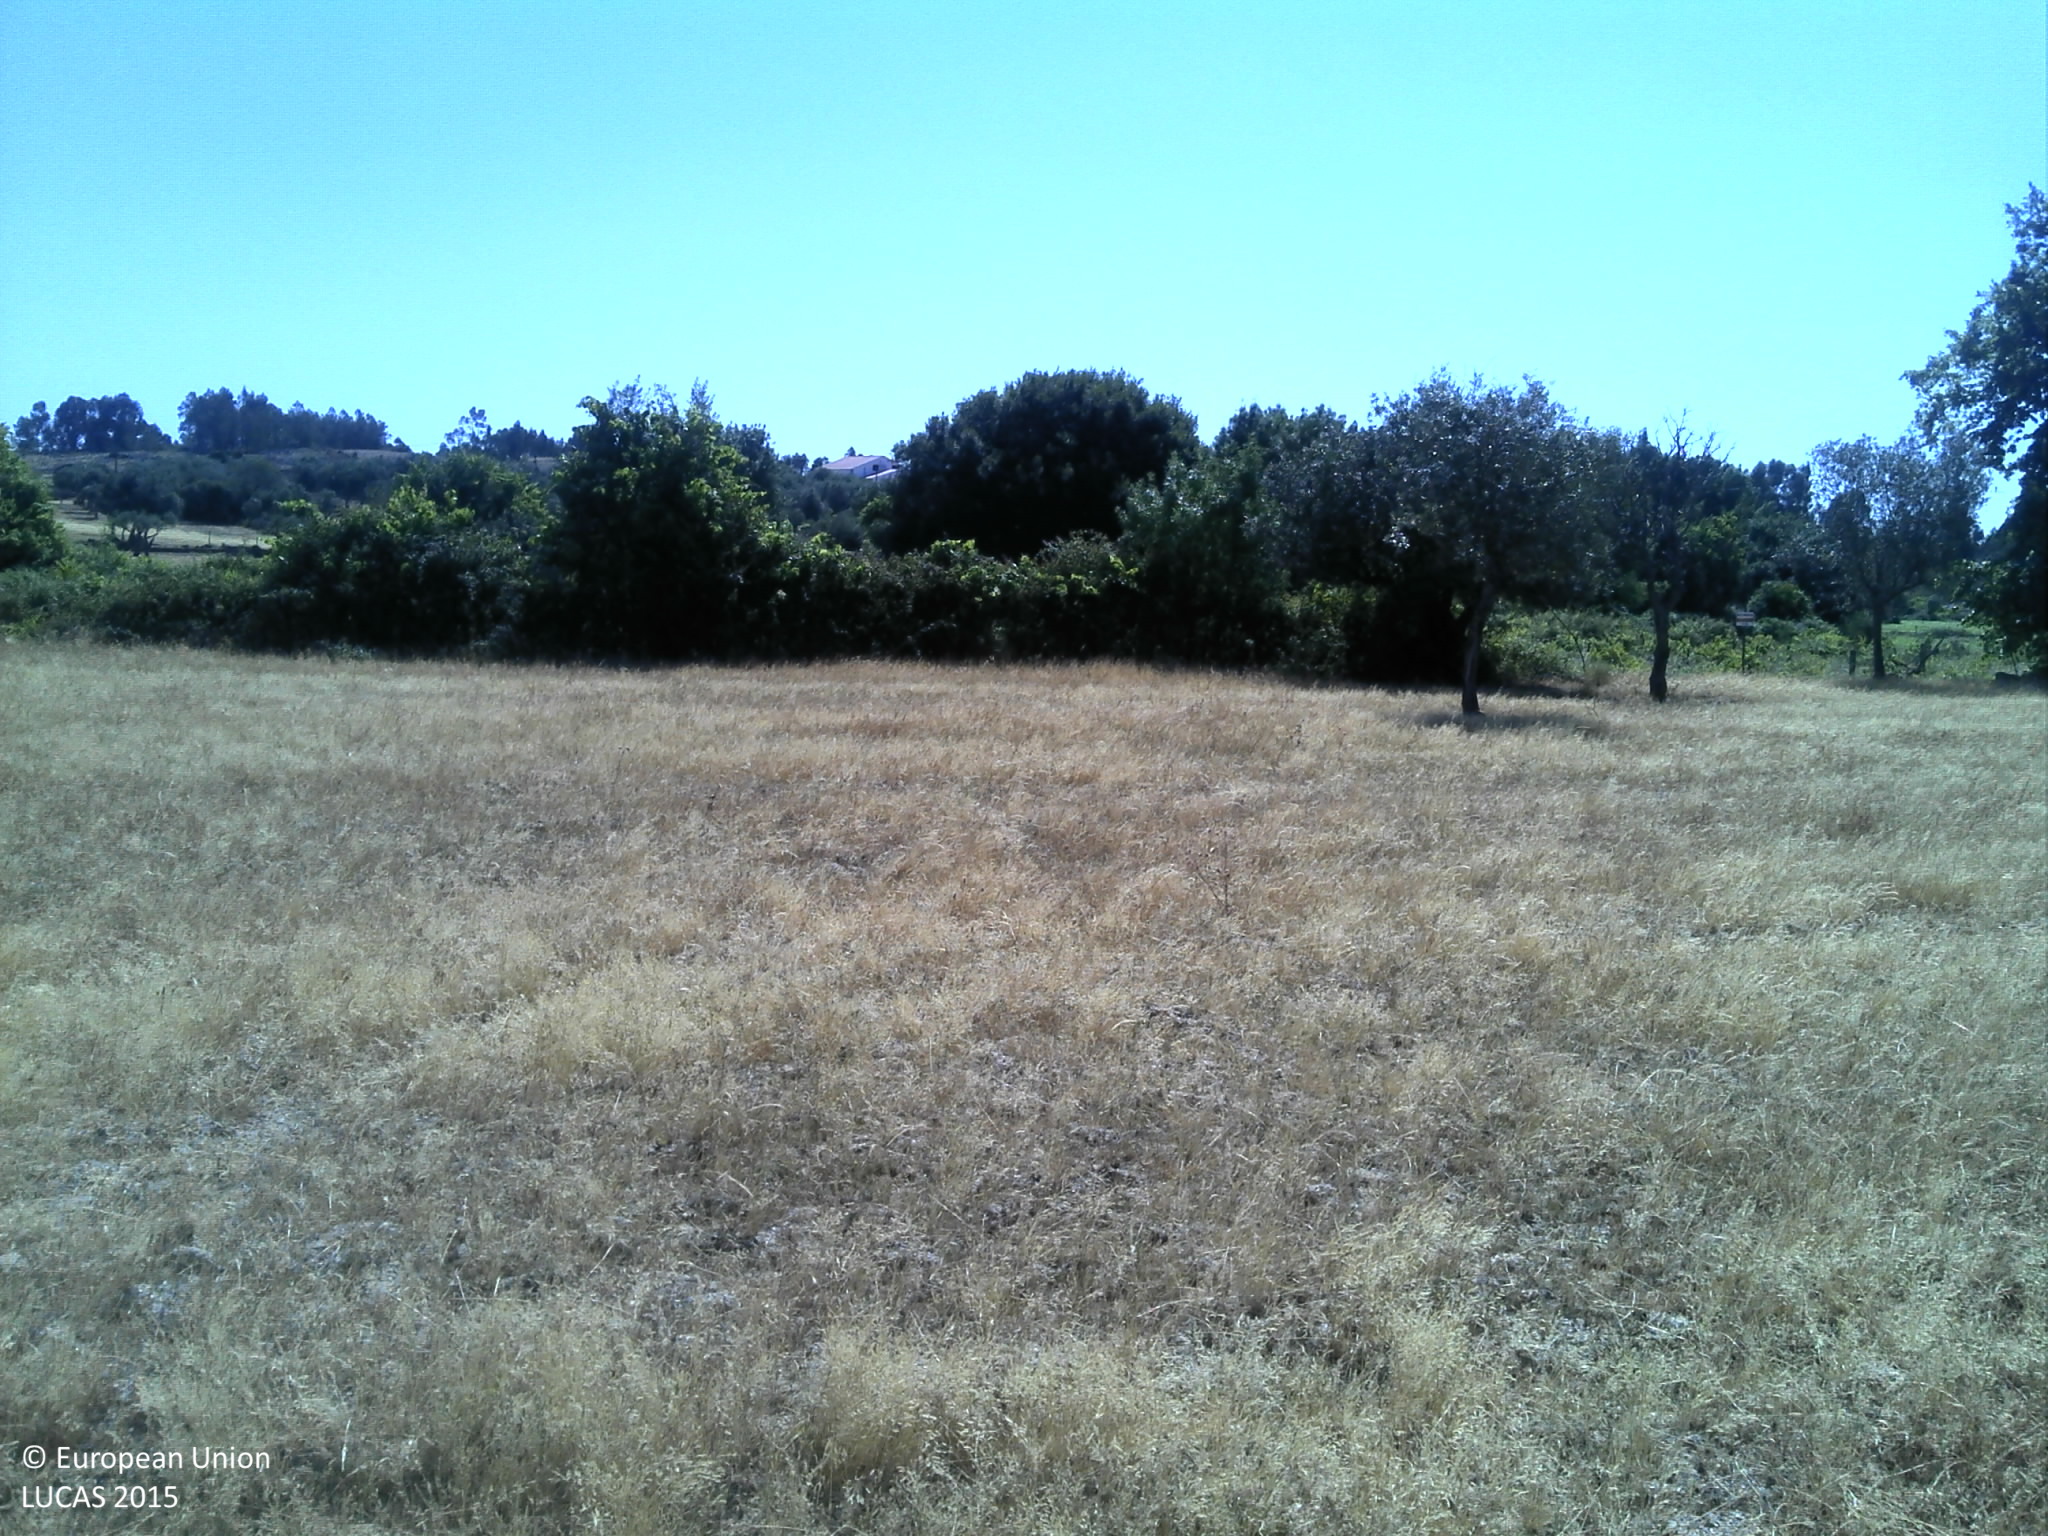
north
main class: Grassland
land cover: Spontaneously vegetated surfaces
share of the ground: 50 - 75 %
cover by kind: herbaceous plants 60 %, unconsolidated bare surface 40 %
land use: Fallow land
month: June
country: PT
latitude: 40.0346
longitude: -7.3619
